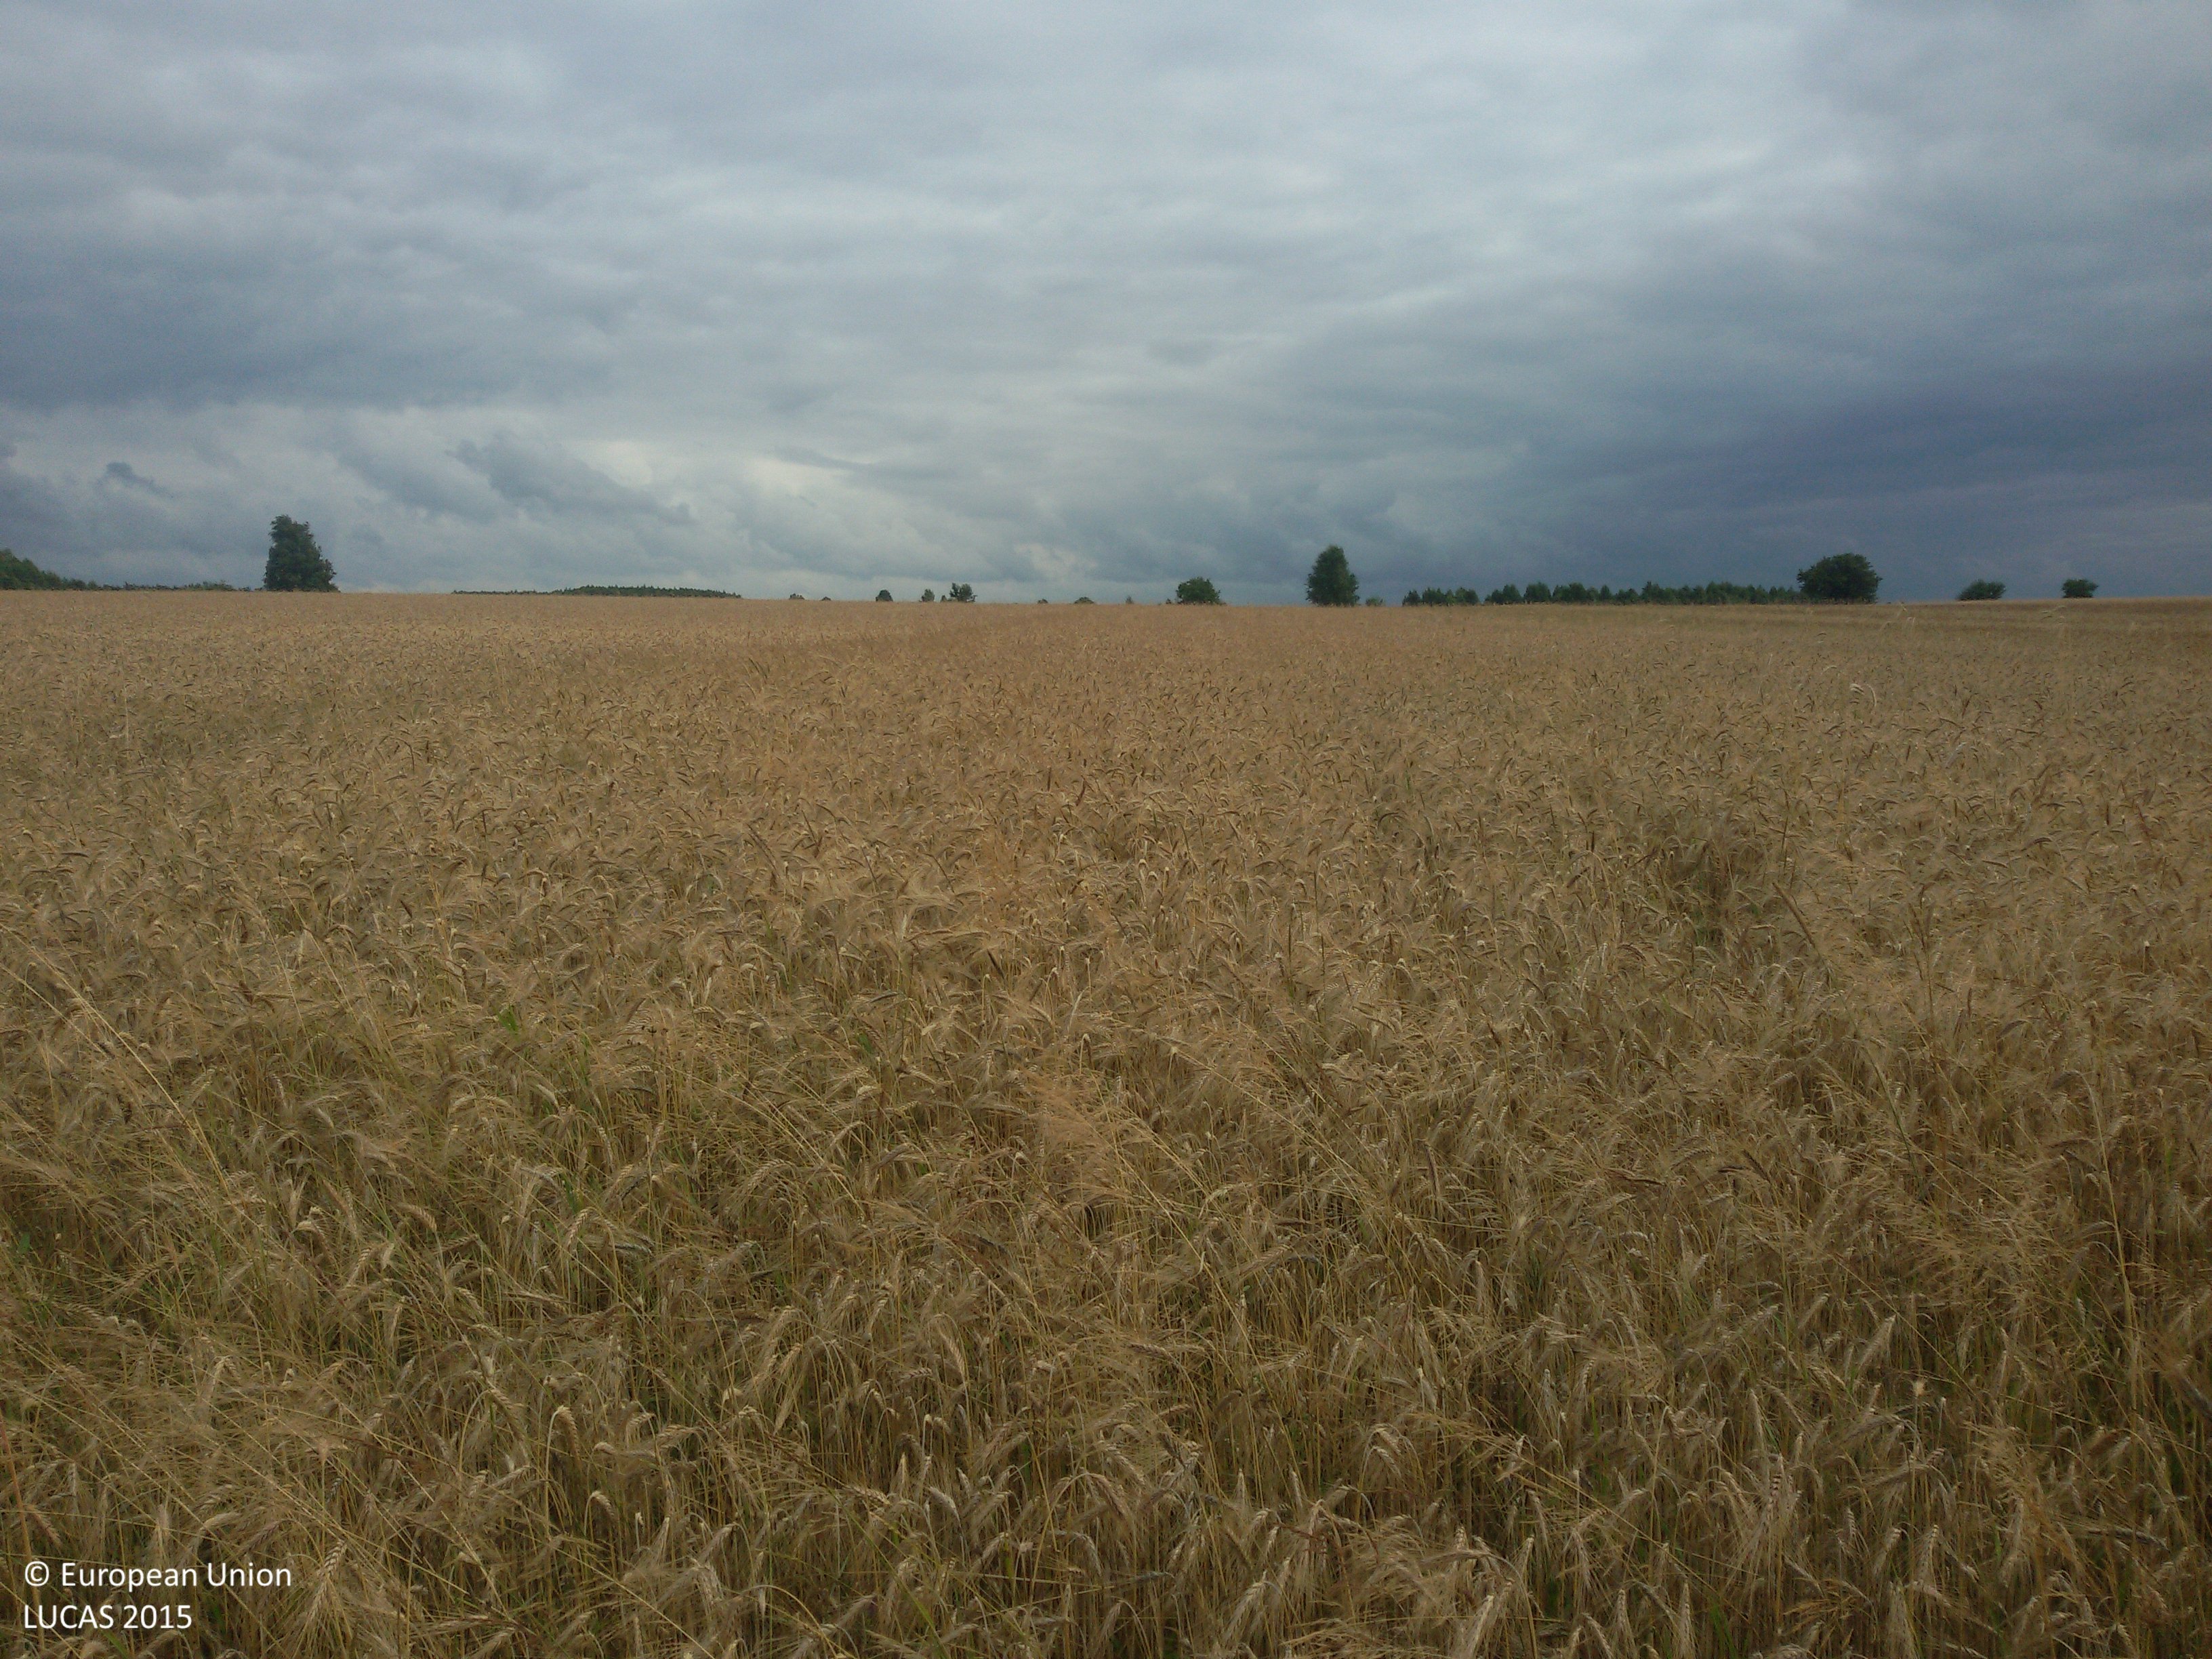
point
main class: Cropland
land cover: Triticale
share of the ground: > 75 %
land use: Agriculture (excluding fallow land and kitchen gardens)
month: July
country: PL
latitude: 53.6379
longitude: 23.5607
